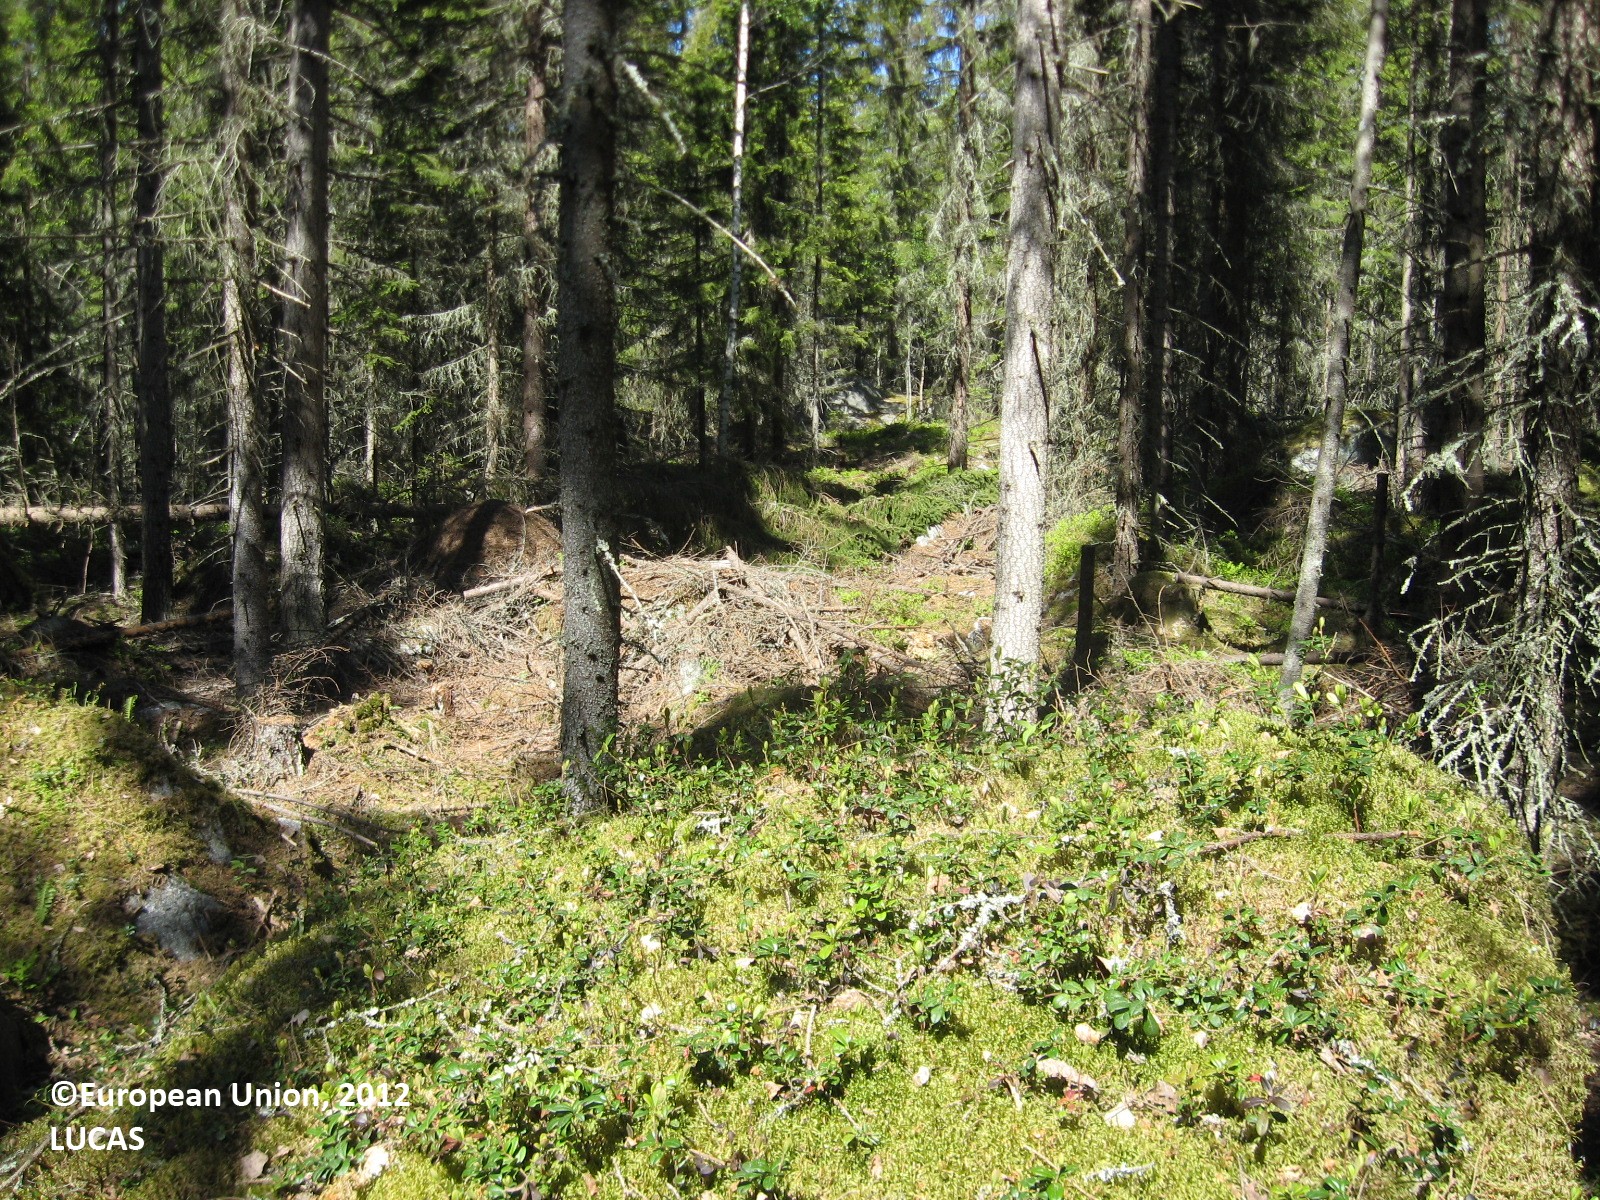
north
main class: Woodland
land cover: Spruce dominated coniferous woodland
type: boreal forest
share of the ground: > 75 %
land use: Forestry
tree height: > 5 m
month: June
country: FI
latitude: 63.2573
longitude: 21.8534
